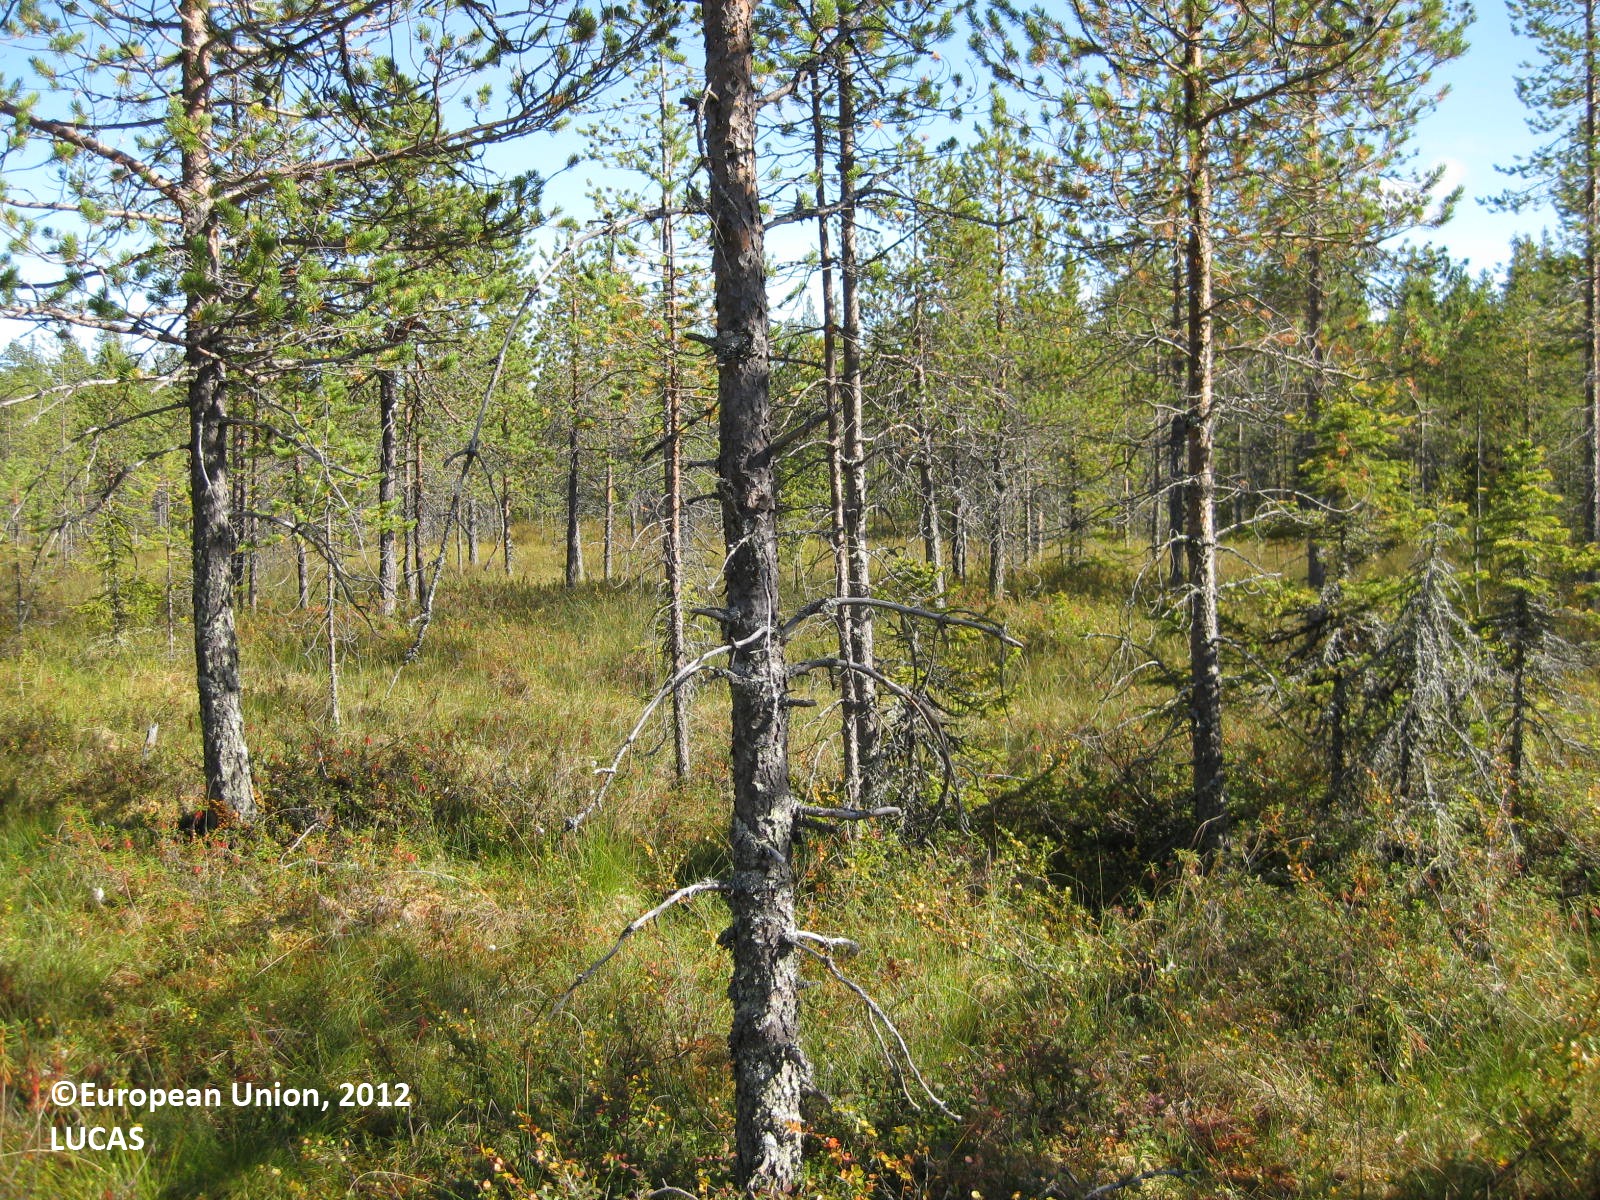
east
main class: Woodland
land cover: Pine dominated coniferous woodland
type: boreal forest
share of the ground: 50 - 75 %
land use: Forestry
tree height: > 5 m
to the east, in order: Pine dominated coniferous woodland; Ditches and canals; Pine dominated coniferous woodland; Ditches and canals; Pine dominated coniferous woodland
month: August
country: FI
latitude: 66.0642
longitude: 29.6097
